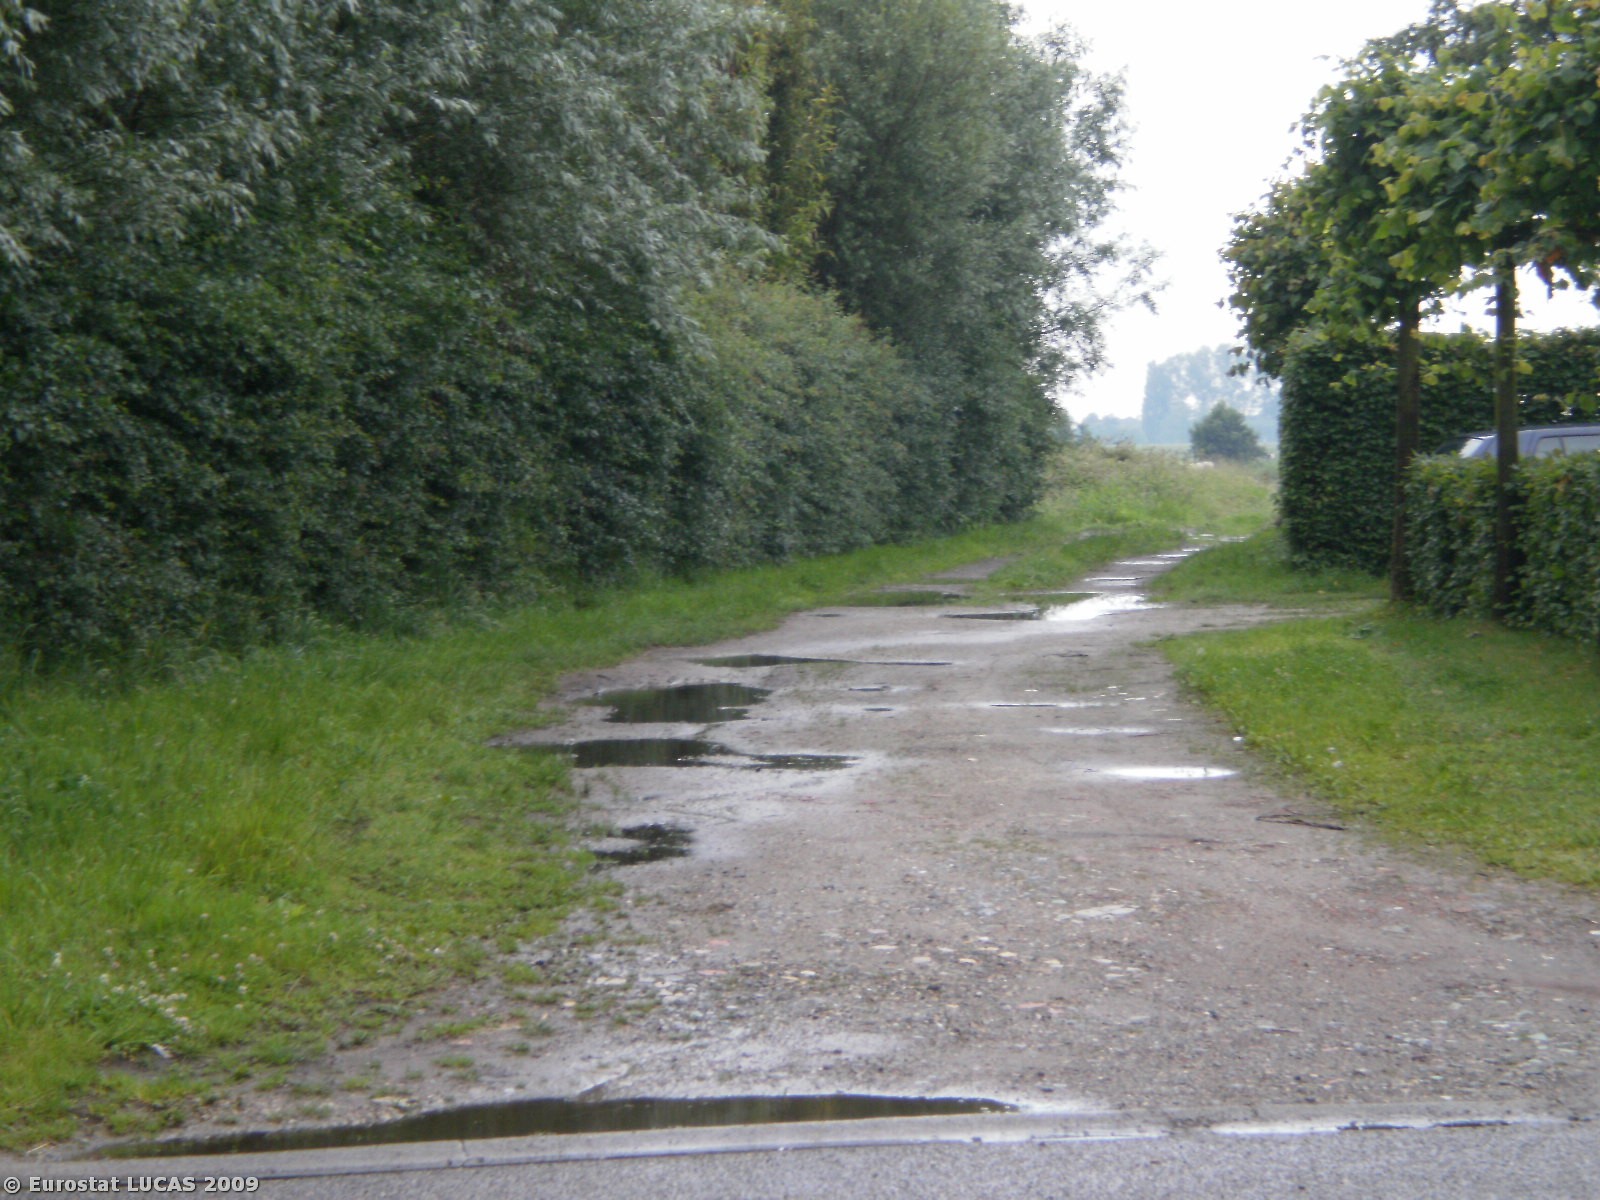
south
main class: Grassland
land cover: Grassland without tree/shrub cover
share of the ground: > 75 %
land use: Agriculture (excluding fallow land and kitchen gardens)
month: June
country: BE
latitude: 51.1337
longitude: 4.1496
